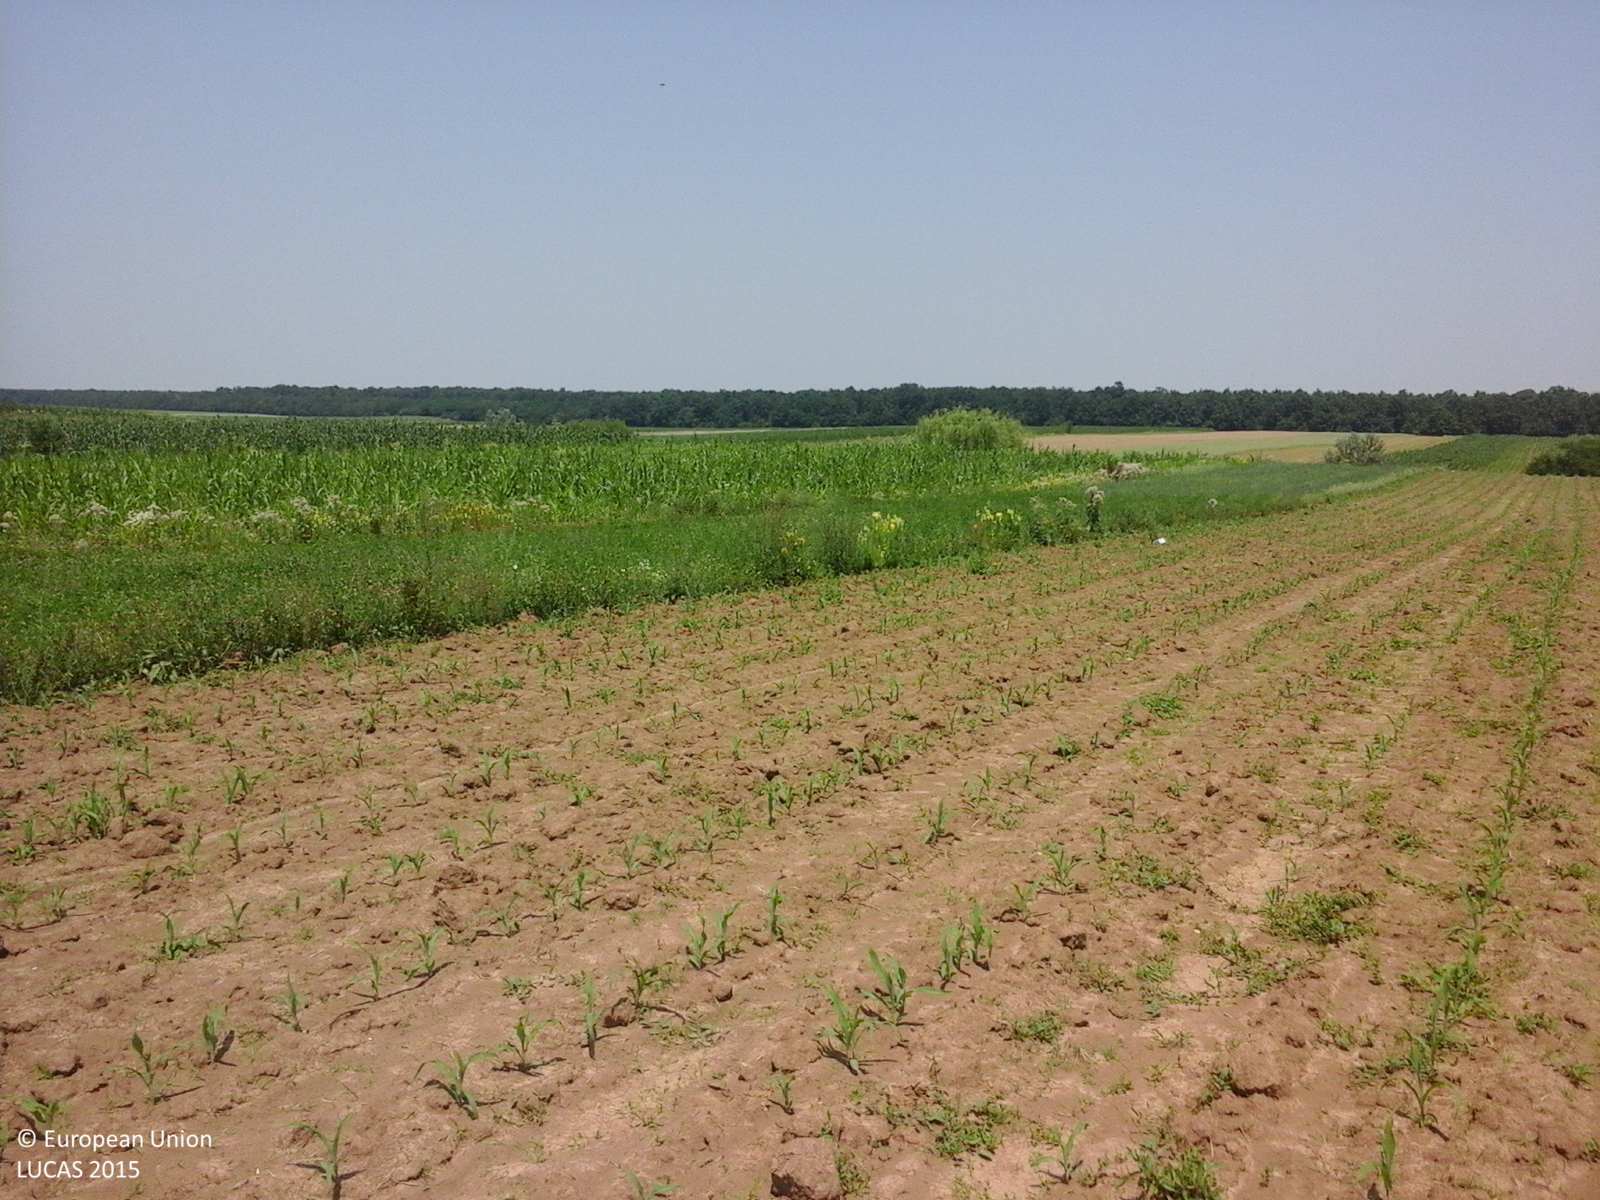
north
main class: Cropland
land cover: Maize
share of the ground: < 10 %
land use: Agriculture (excluding fallow land and kitchen gardens)
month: July
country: RO
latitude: 44.5518
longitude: 25.3843
